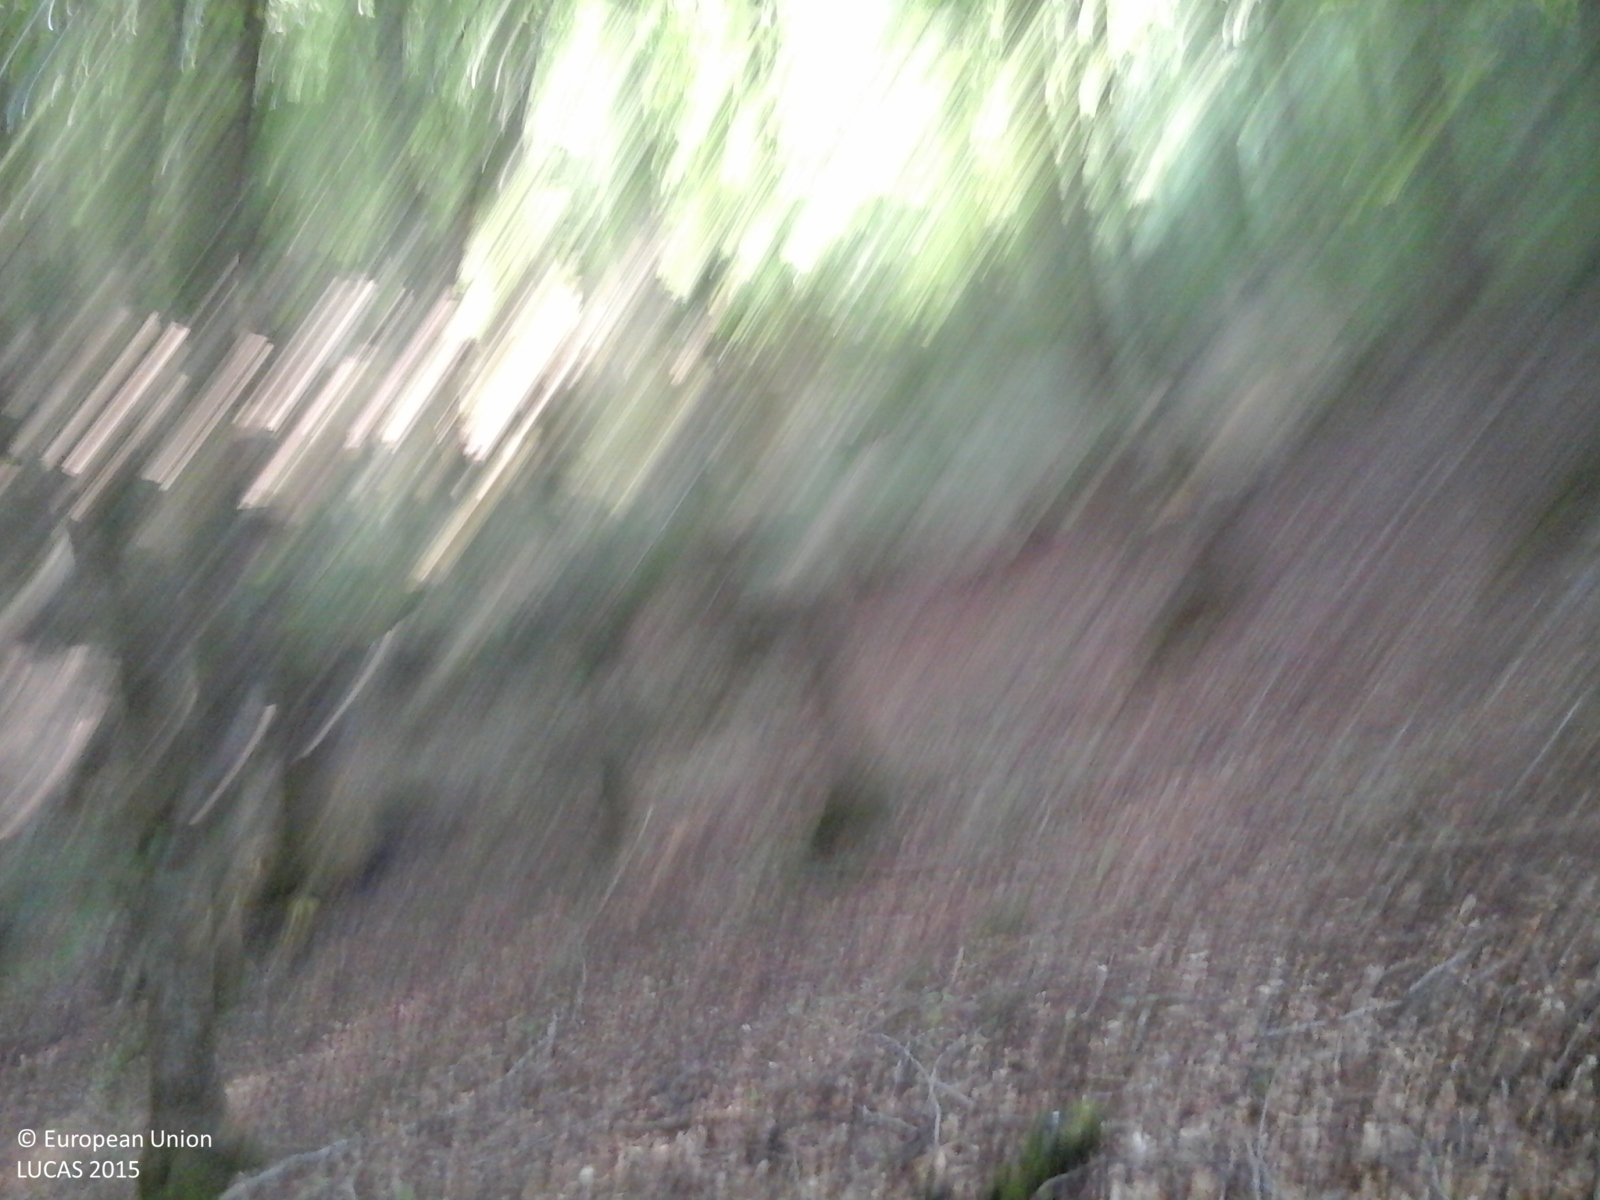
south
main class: Woodland
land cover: Broadleaved woodland
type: mountainous beech forest
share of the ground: > 75 %
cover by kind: broadleaved forest trees 90 %, lichens and mosses 10 %
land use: Semi-natural and natural areas not in use
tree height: > 5 m
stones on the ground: < 10 %
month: August
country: IT
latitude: 43.8108
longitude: 11.8476
